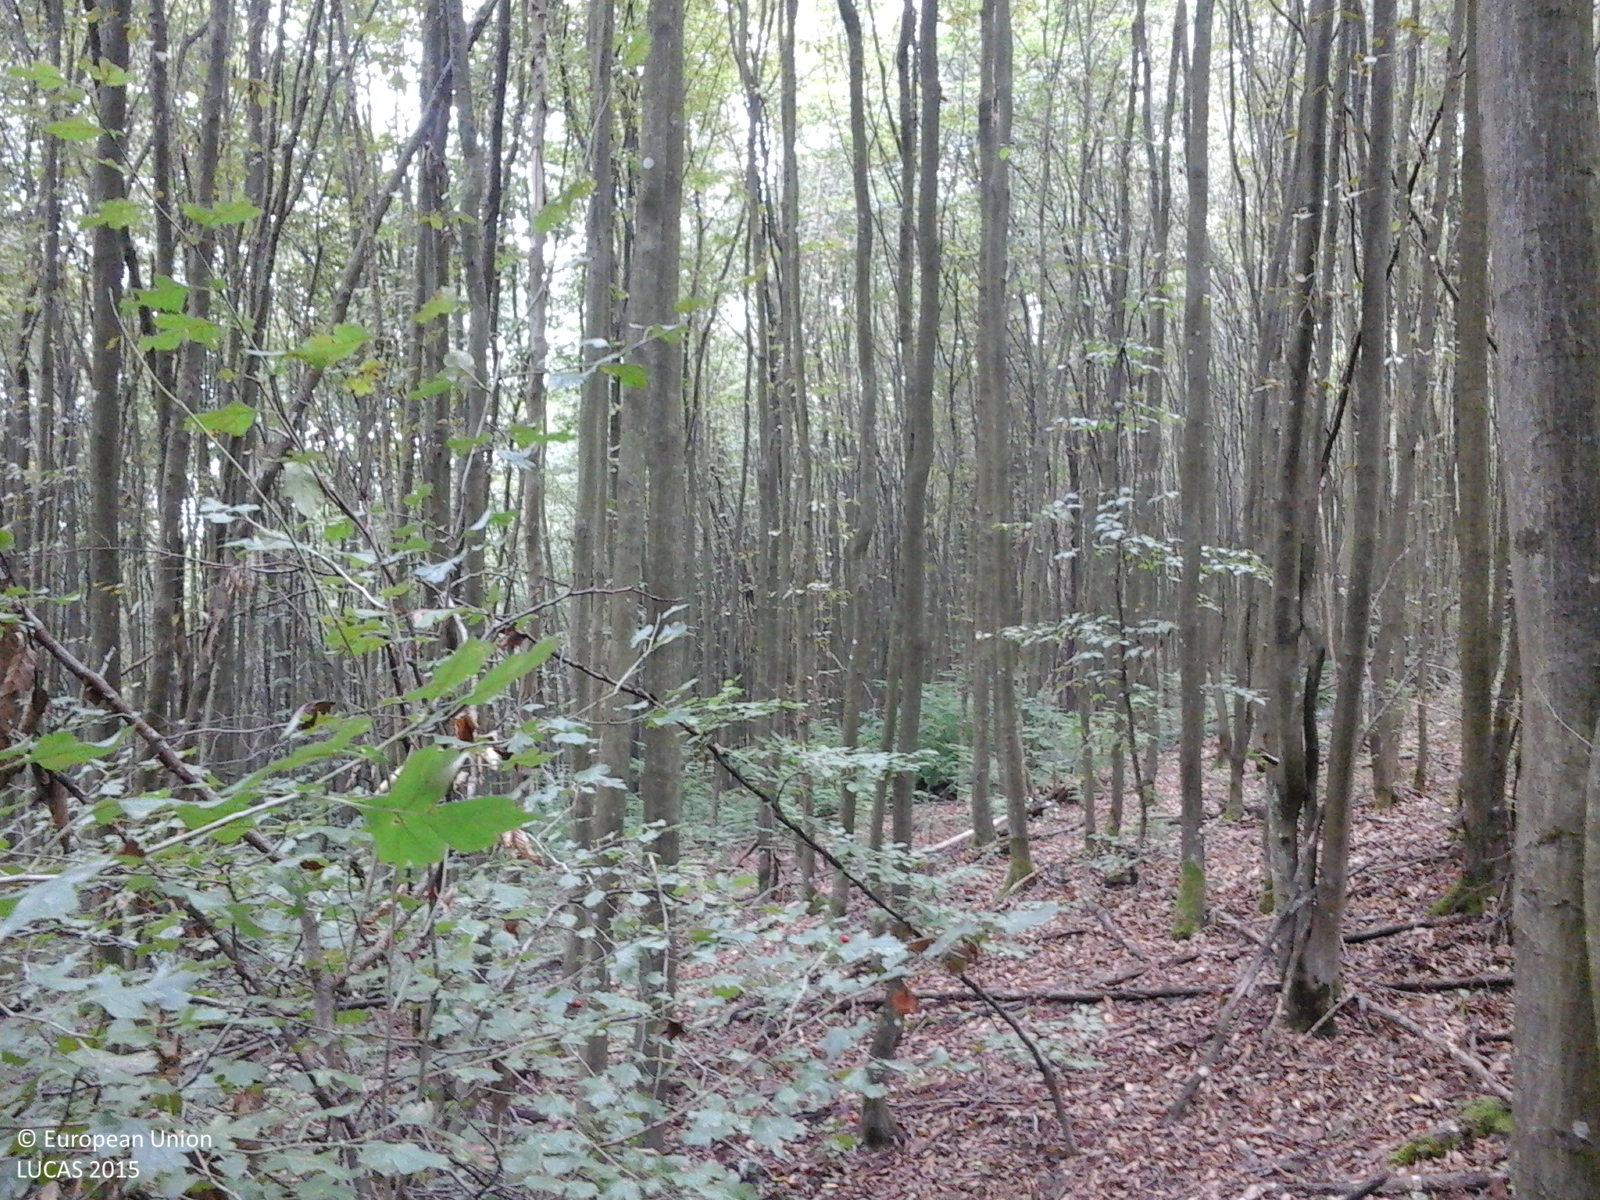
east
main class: Woodland
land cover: Broadleaved woodland
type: mesophytic deciduous forest
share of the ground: > 75 %
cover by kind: broadleaved forest trees 100 %
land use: Forestry
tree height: > 5 m
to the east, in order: Broadleaved woodland; Tracks; Broadleaved woodland
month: September
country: RO
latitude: 45.9137
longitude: 22.1228
